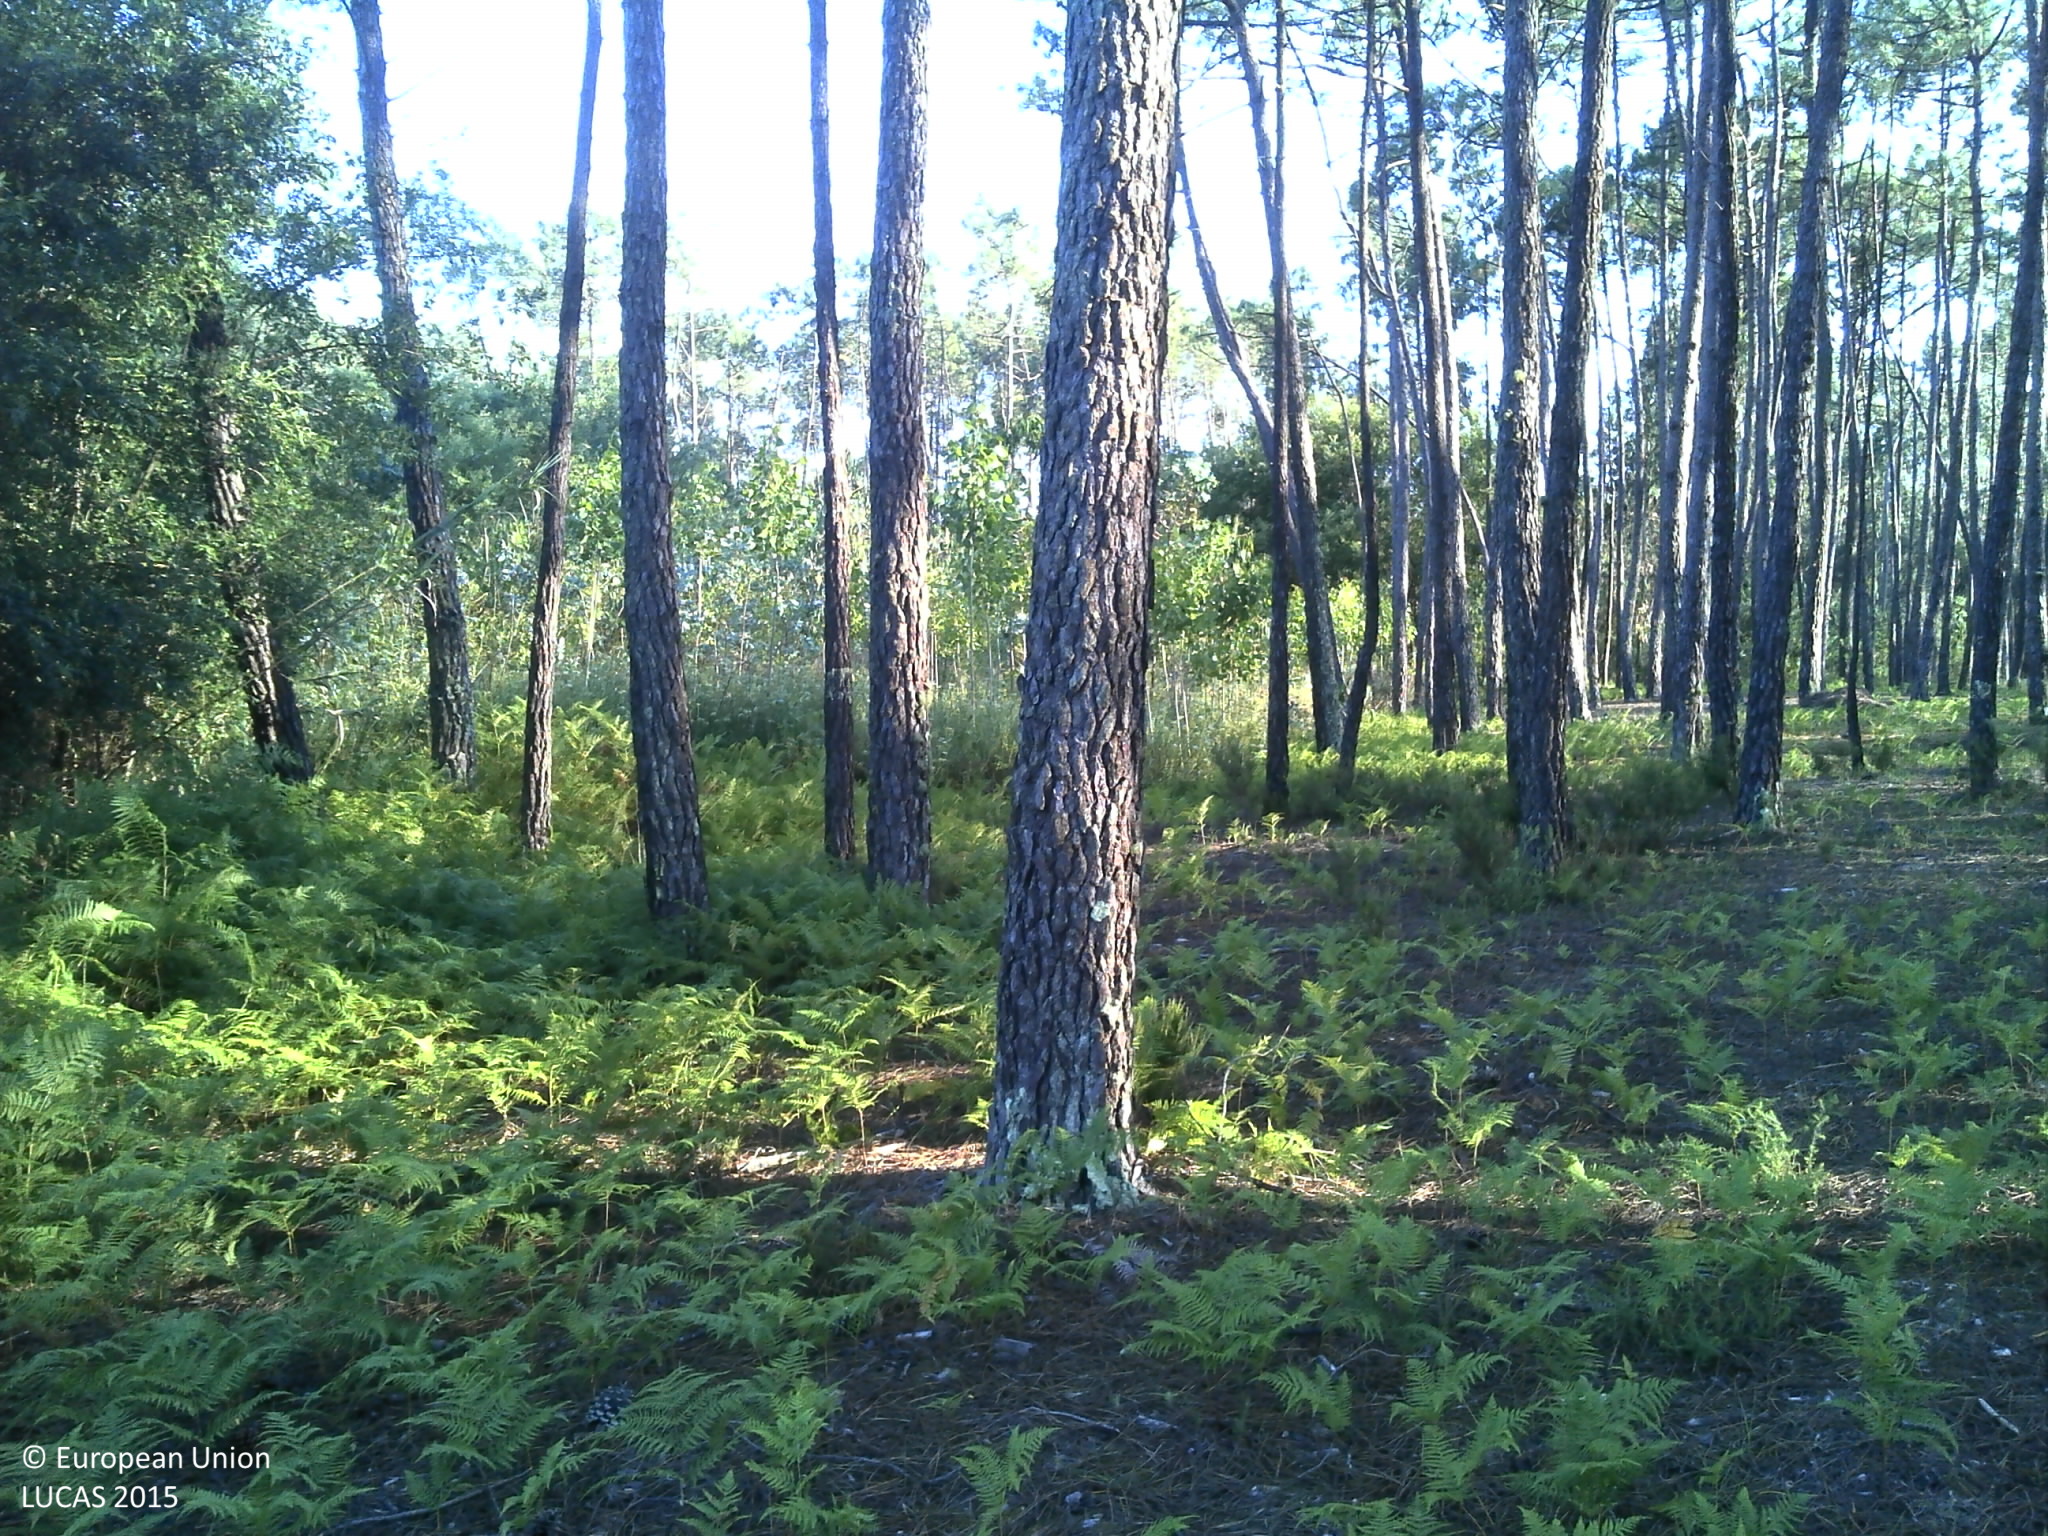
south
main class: Woodland
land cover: Pine dominated coniferous woodland
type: coniferous forest of the mediterranean region
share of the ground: 50 - 75 %
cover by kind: coniferous forest trees 75 %, shrubs 10 %, herbaceous plants 10 %, unconsolidated bare surface 5 %
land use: Forestry
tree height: > 5 m
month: May
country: PT
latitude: 40.4169
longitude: -8.6798
